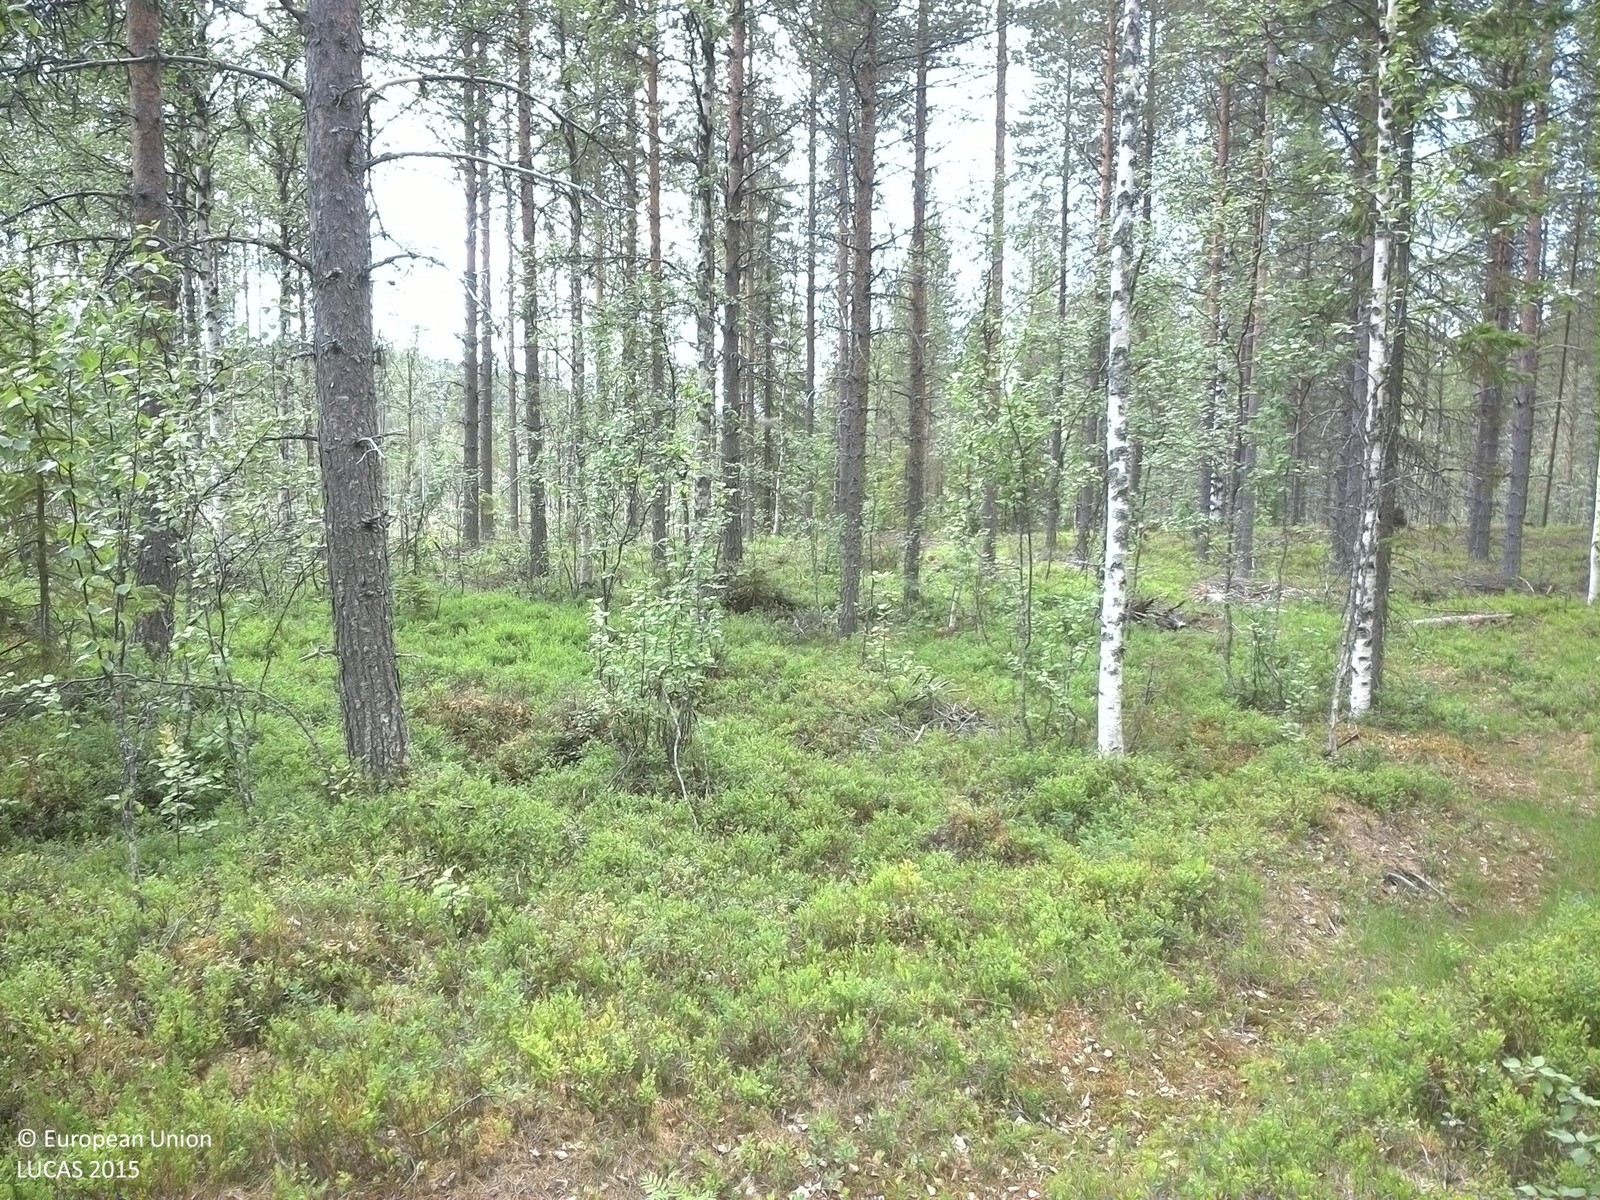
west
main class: Woodland
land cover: Pine dominated mixed woodland
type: boreal forest
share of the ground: 25 - 50 %
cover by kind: coniferous forest trees 35 %, shrubs 30 %, broadleaved forest trees 15 %, lichens and mosses 10 %, herbaceous plants 5 %, unconsolidated bare surface 5 %
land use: Forestry
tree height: > 5 m
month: July
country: SE
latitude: 64.1986
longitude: 16.7854
